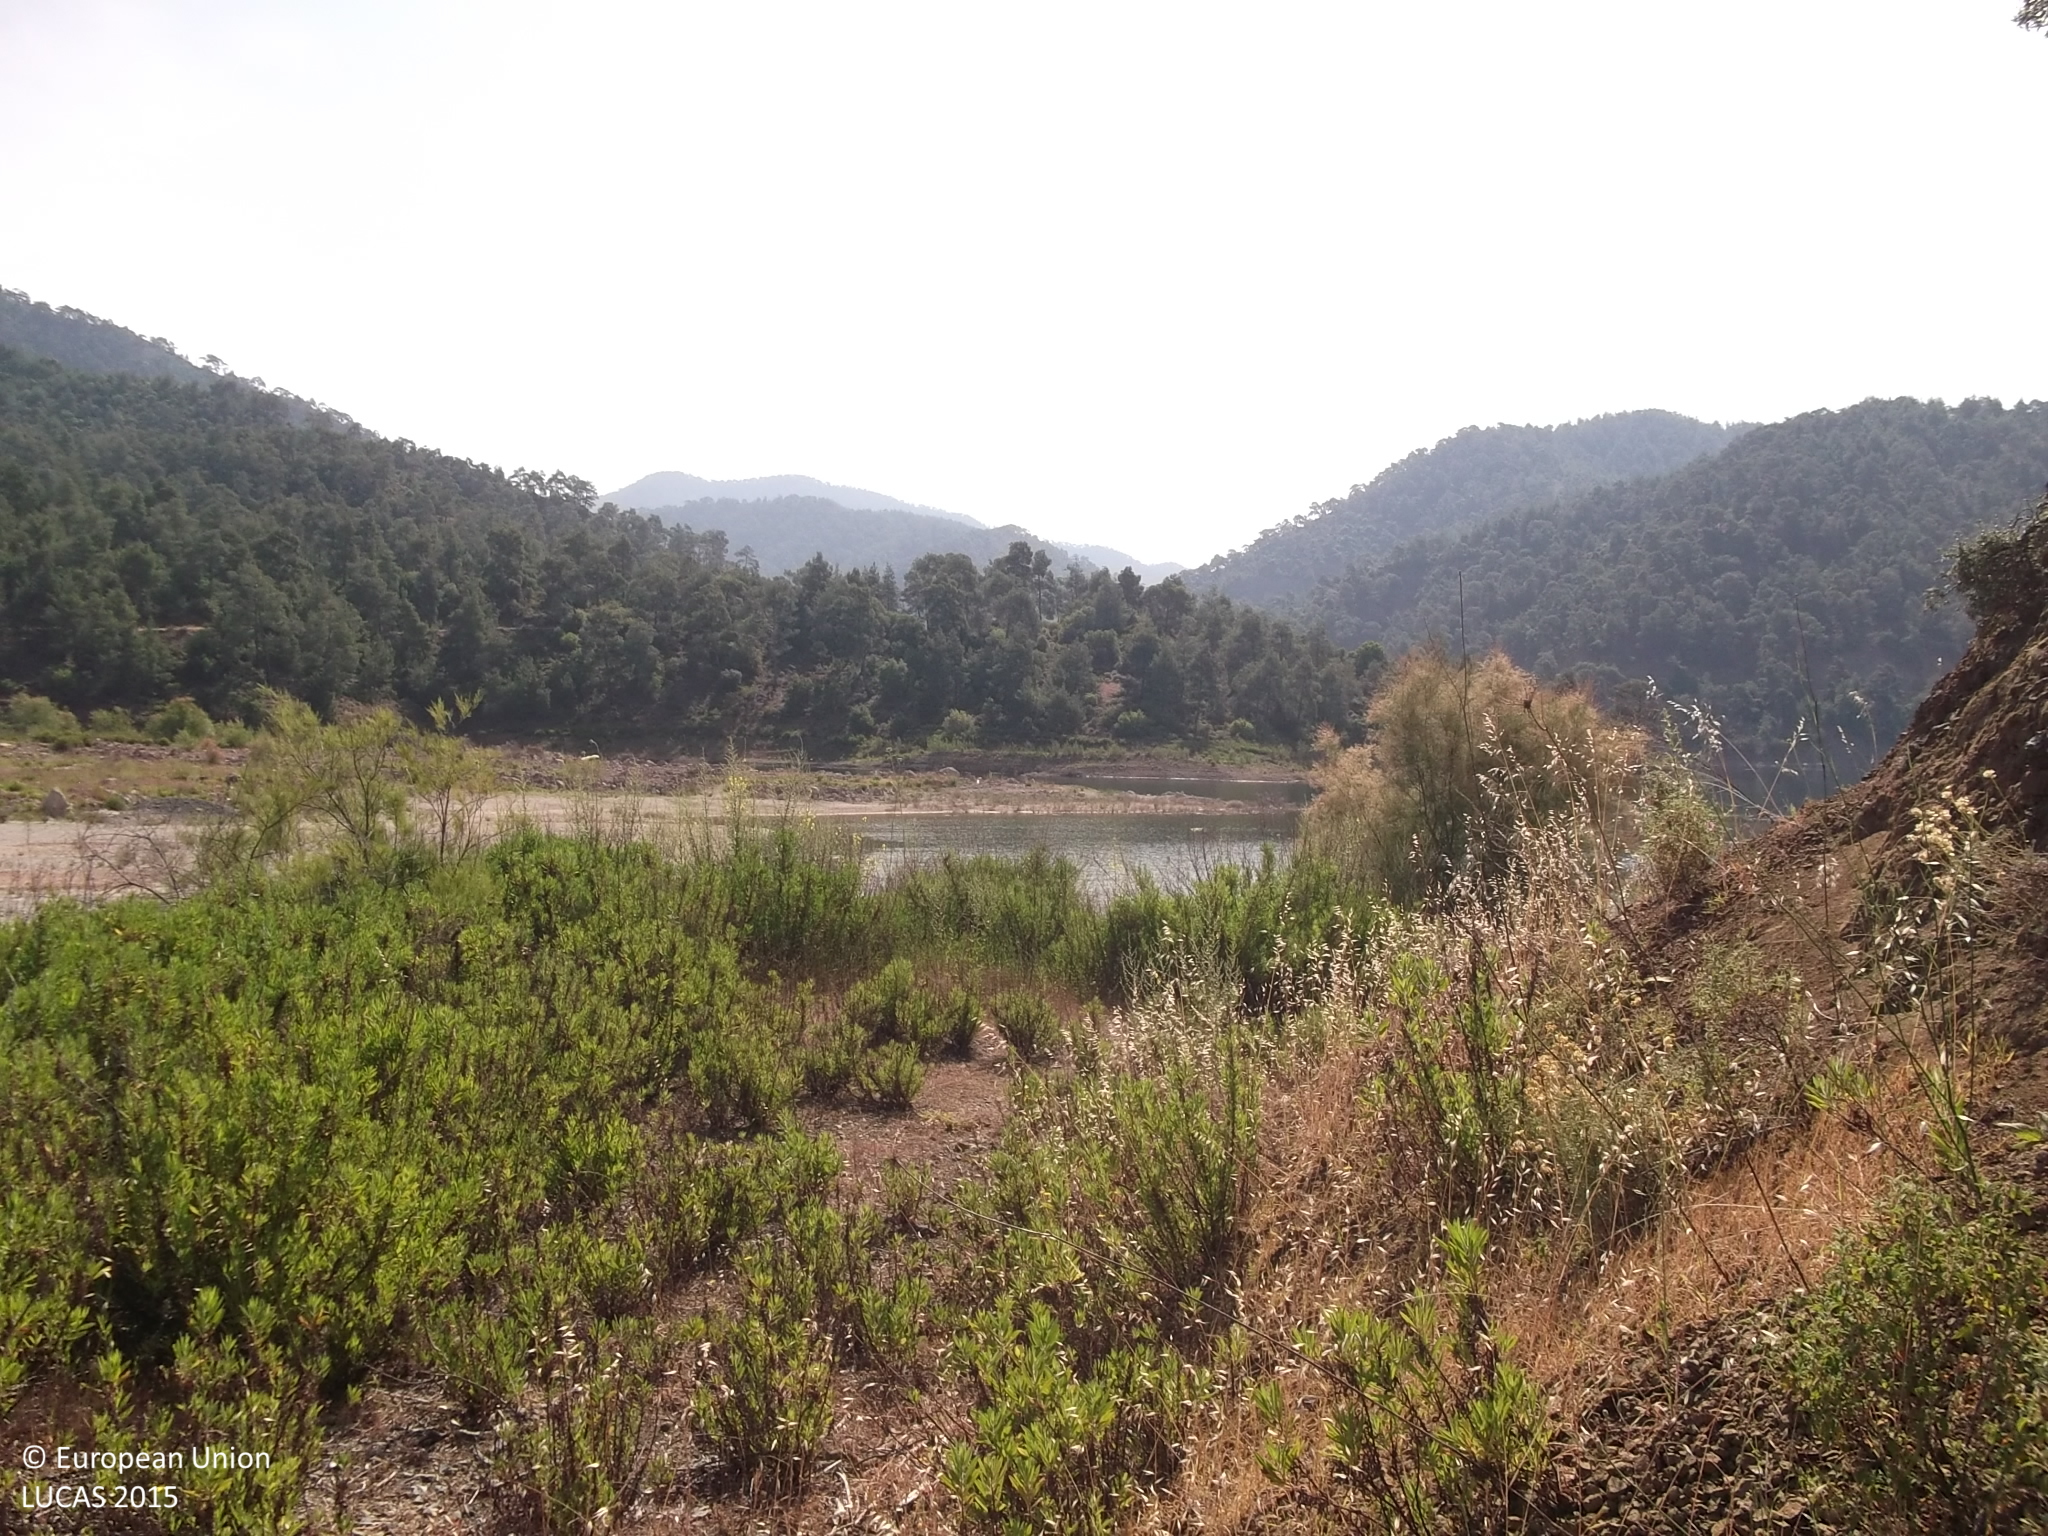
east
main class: Woodland
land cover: Other mixed woodland
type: coniferous forest of the mediterranean region
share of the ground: > 75 %
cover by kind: broadleaved forest trees 40 %, coniferous forest trees 30 %, shrubs 15 %, unconsolidated bare surface 15 %
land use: Semi-natural and natural areas not in use
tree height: > 5 m
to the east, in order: Other mixed woodland; Other bare soil; Inland fresh water bodies; Rocks and stones; Inland fresh water bodies
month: May
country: CY
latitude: 34.9355
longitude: 32.5889
